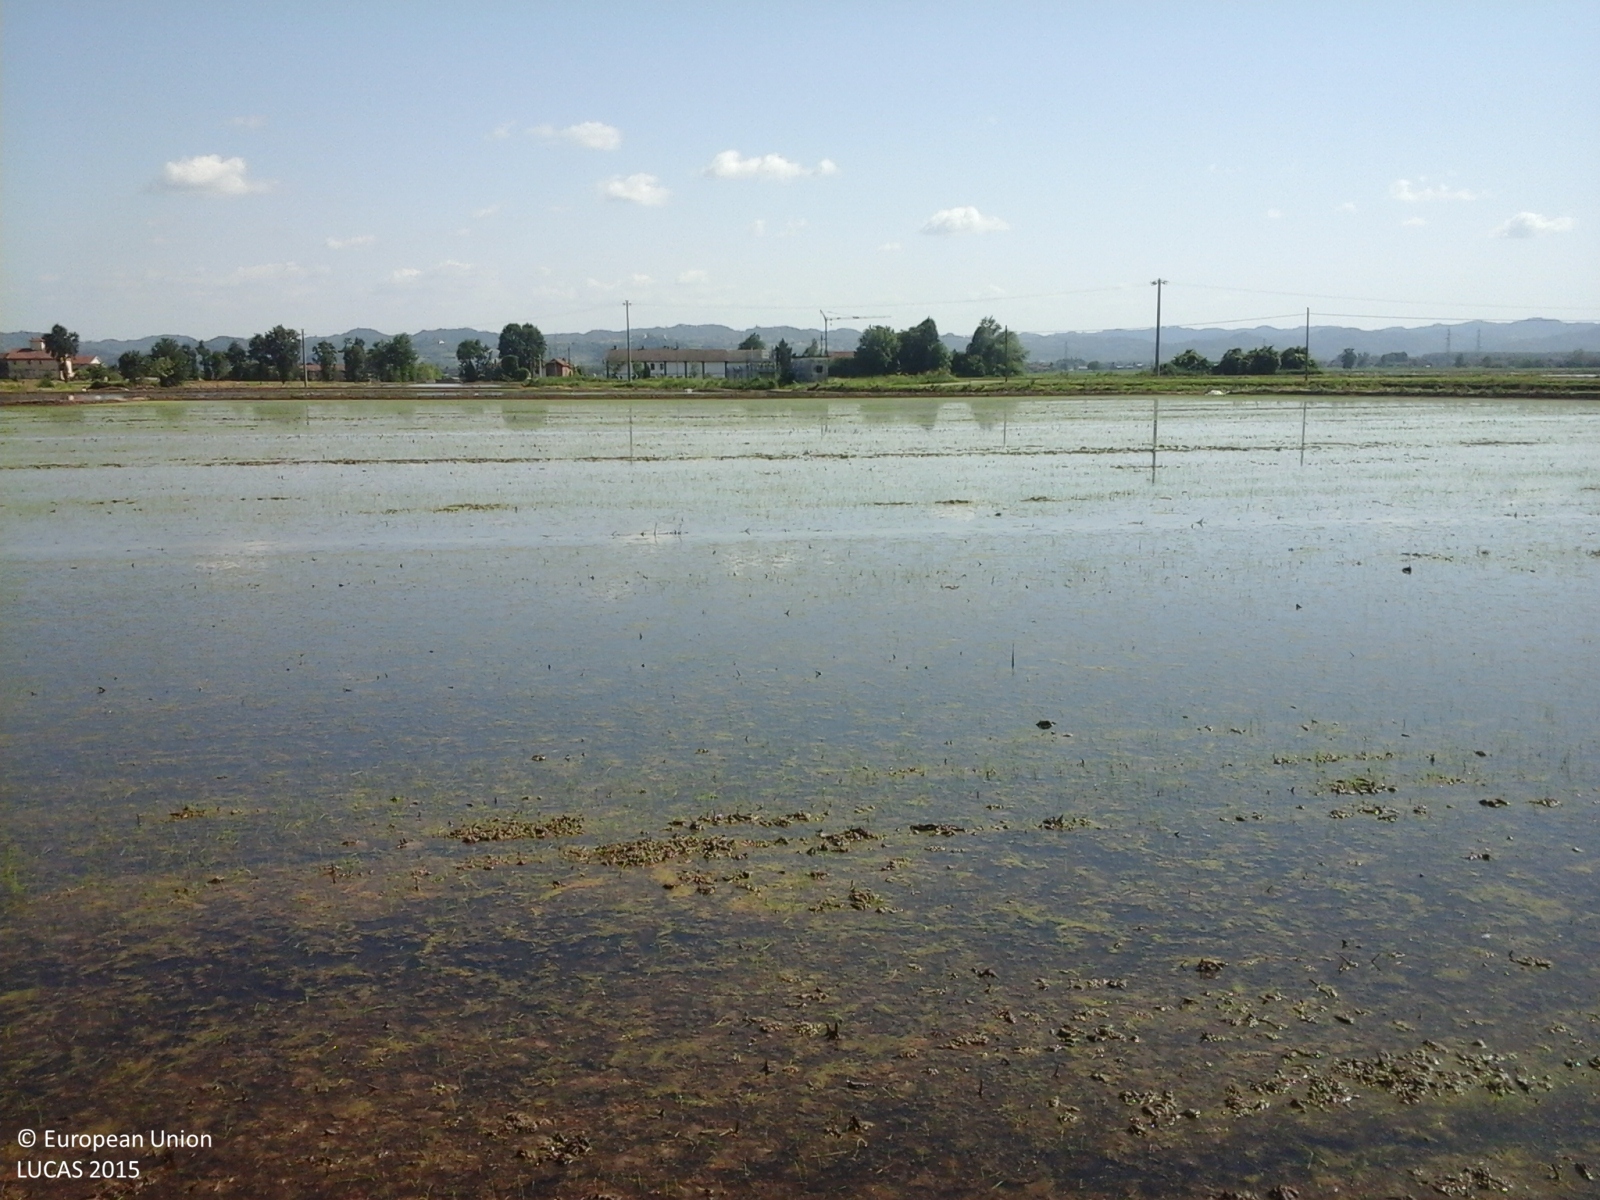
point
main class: Cropland
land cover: Rice
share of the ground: > 75 %
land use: Agriculture (excluding fallow land and kitchen gardens)
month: May
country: IT
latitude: 45.2170
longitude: 8.1059
